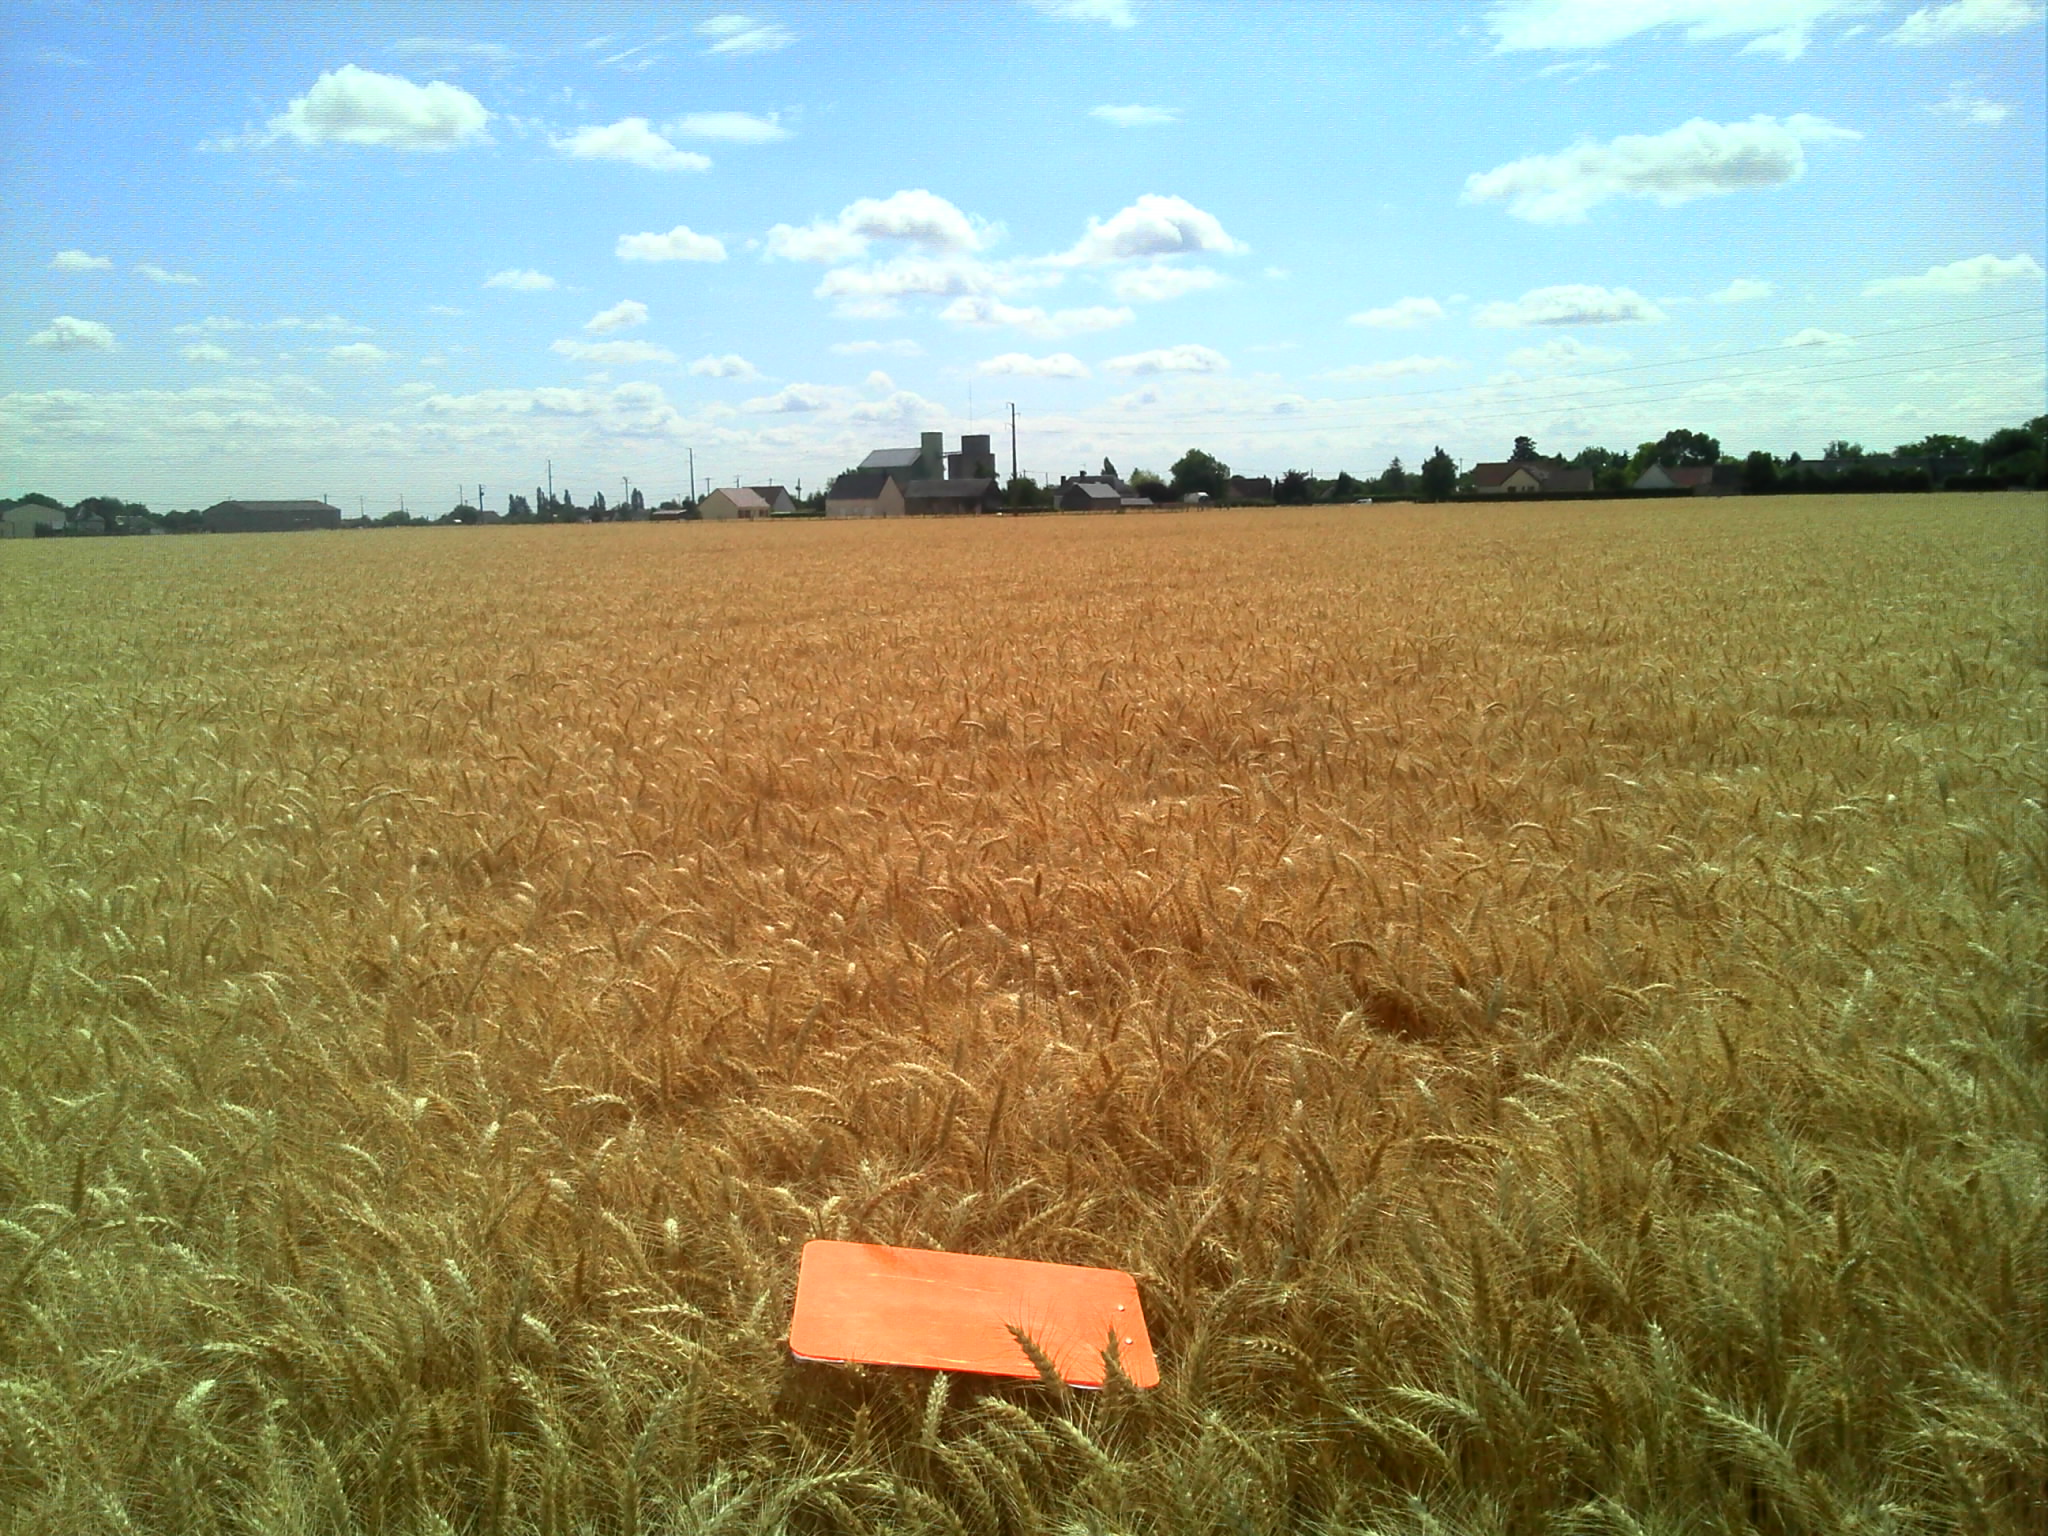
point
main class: Cropland
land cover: Common wheat
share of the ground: > 75 %
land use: Agriculture (excluding fallow land and kitchen gardens)
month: July
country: FR
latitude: 48.8790
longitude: 1.1300
